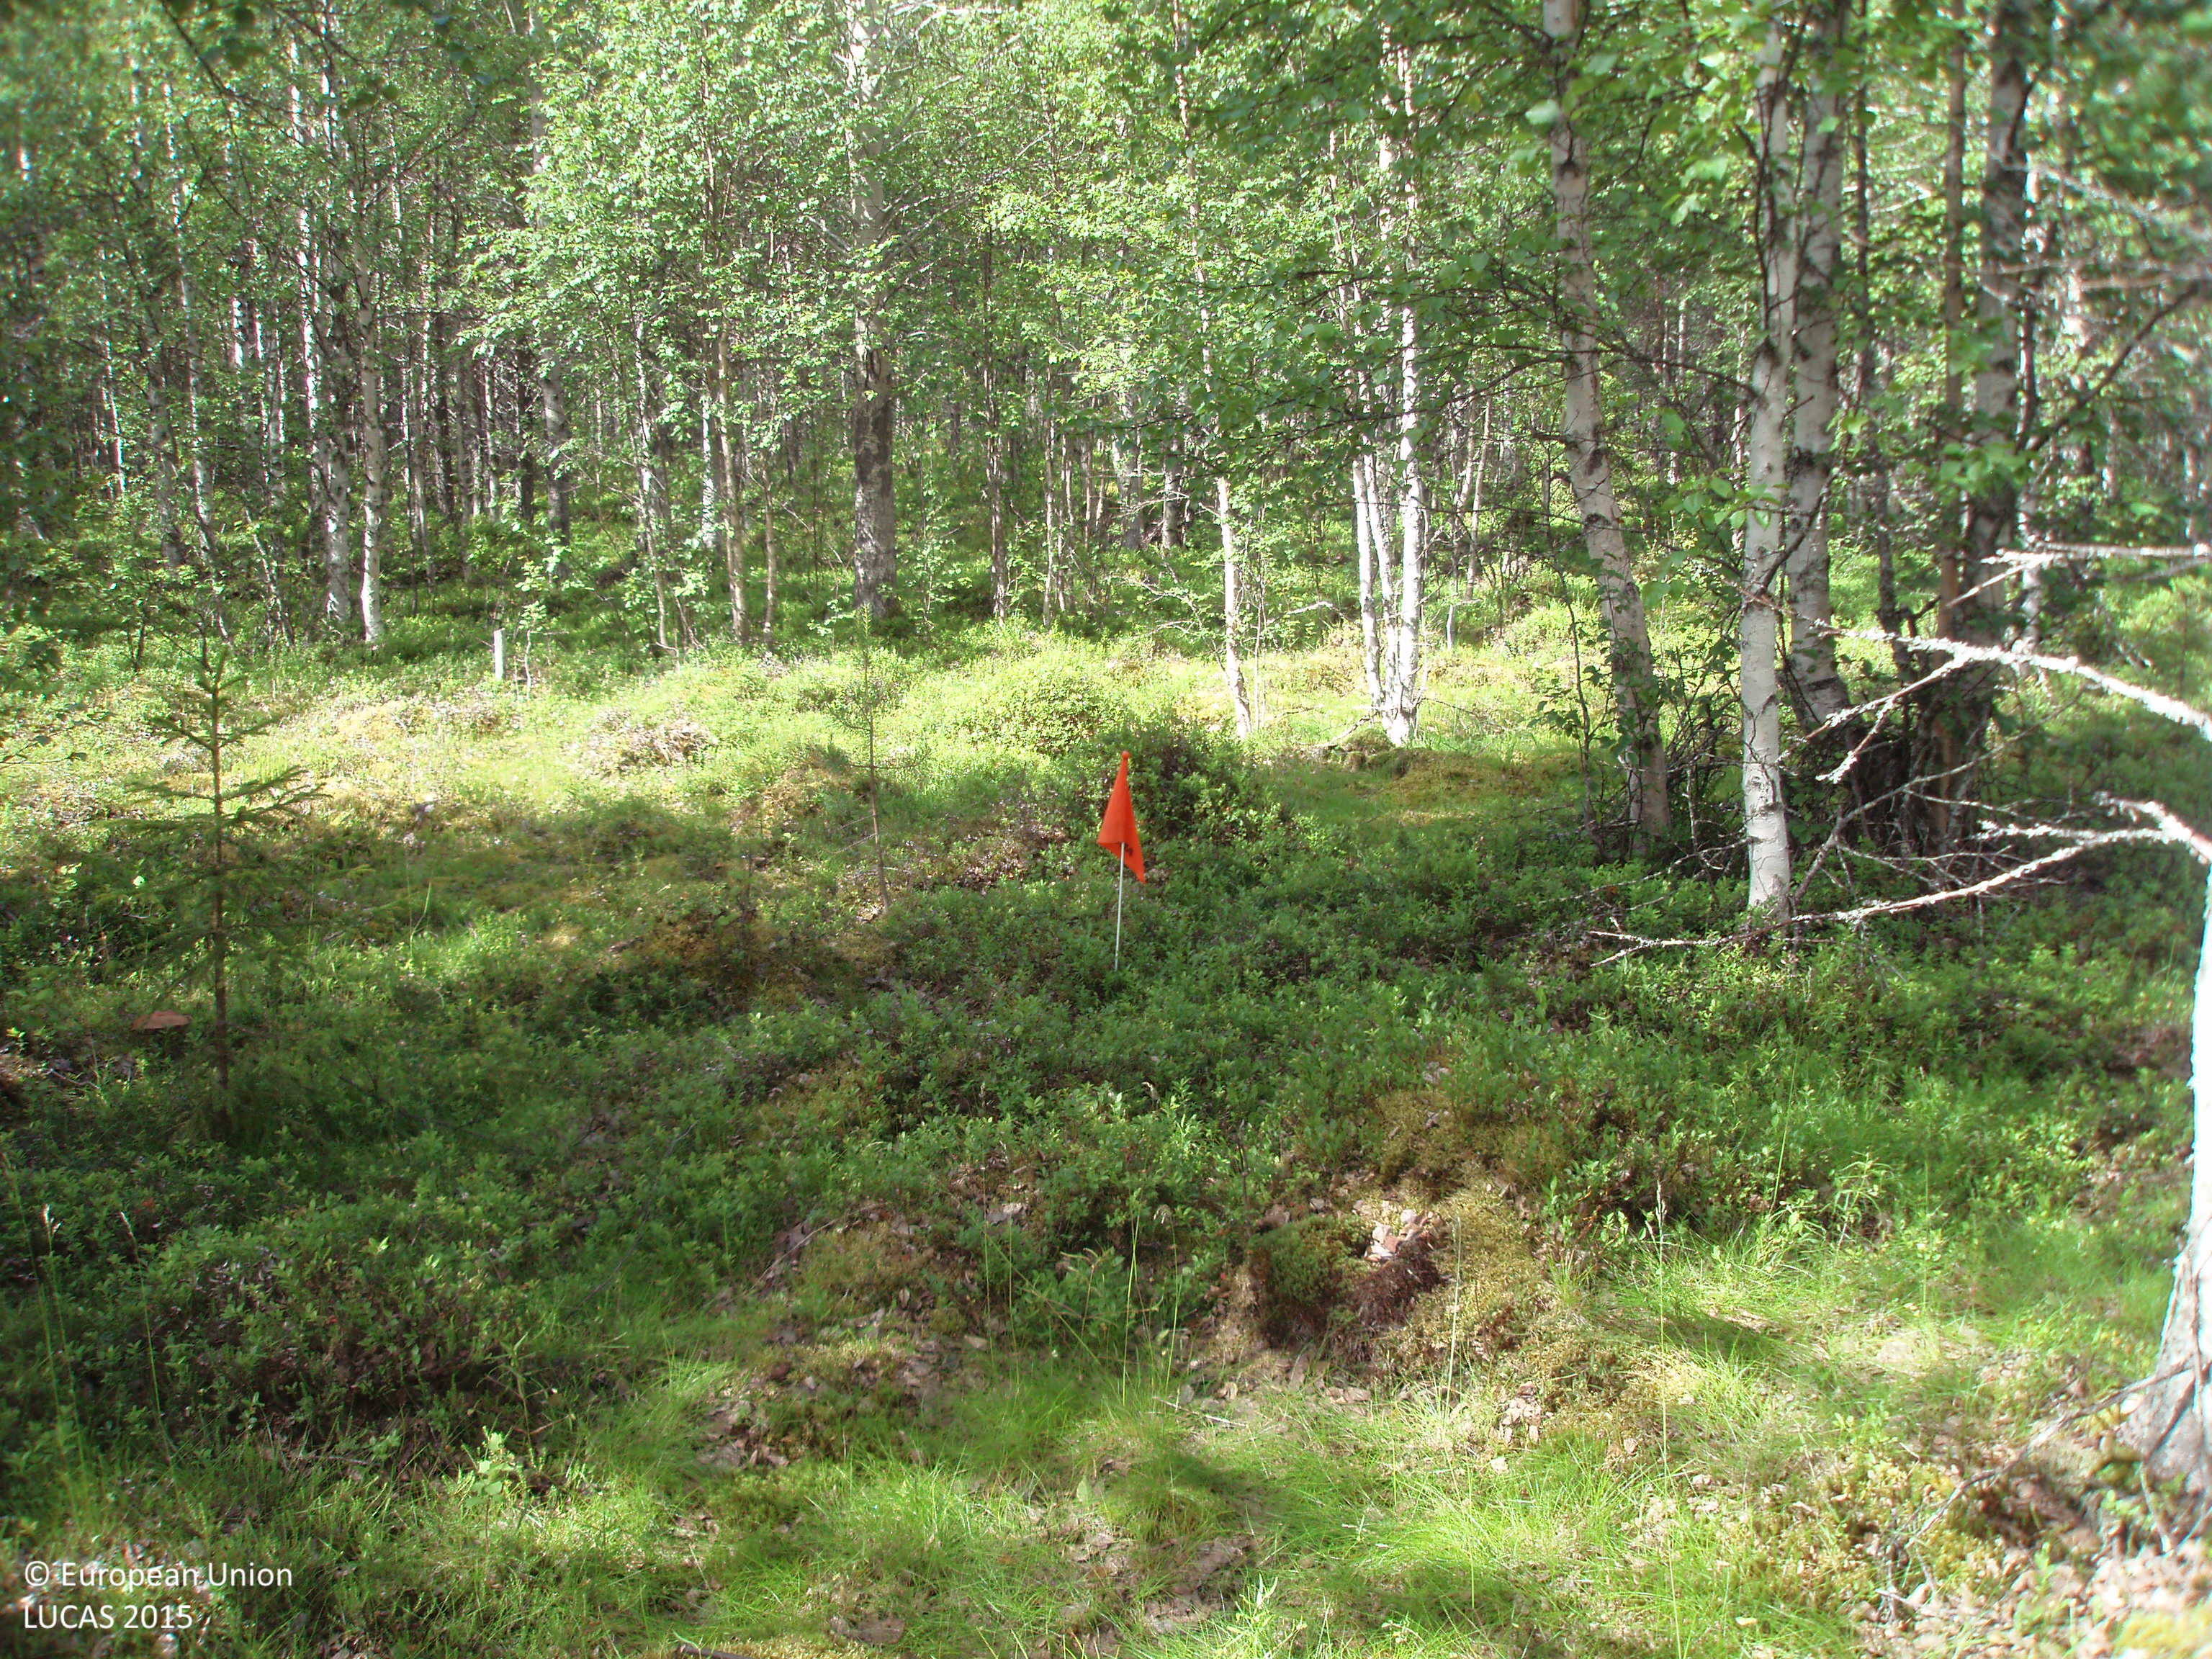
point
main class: Woodland
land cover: Broadleaved woodland
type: boreal forest
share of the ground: > 75 %
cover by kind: broadleaved forest trees 75 %, shrubs 20 %, coniferous forest trees 5 %
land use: Forestry
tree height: > 5 m
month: July
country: FI
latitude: 66.9529
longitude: 28.2357
